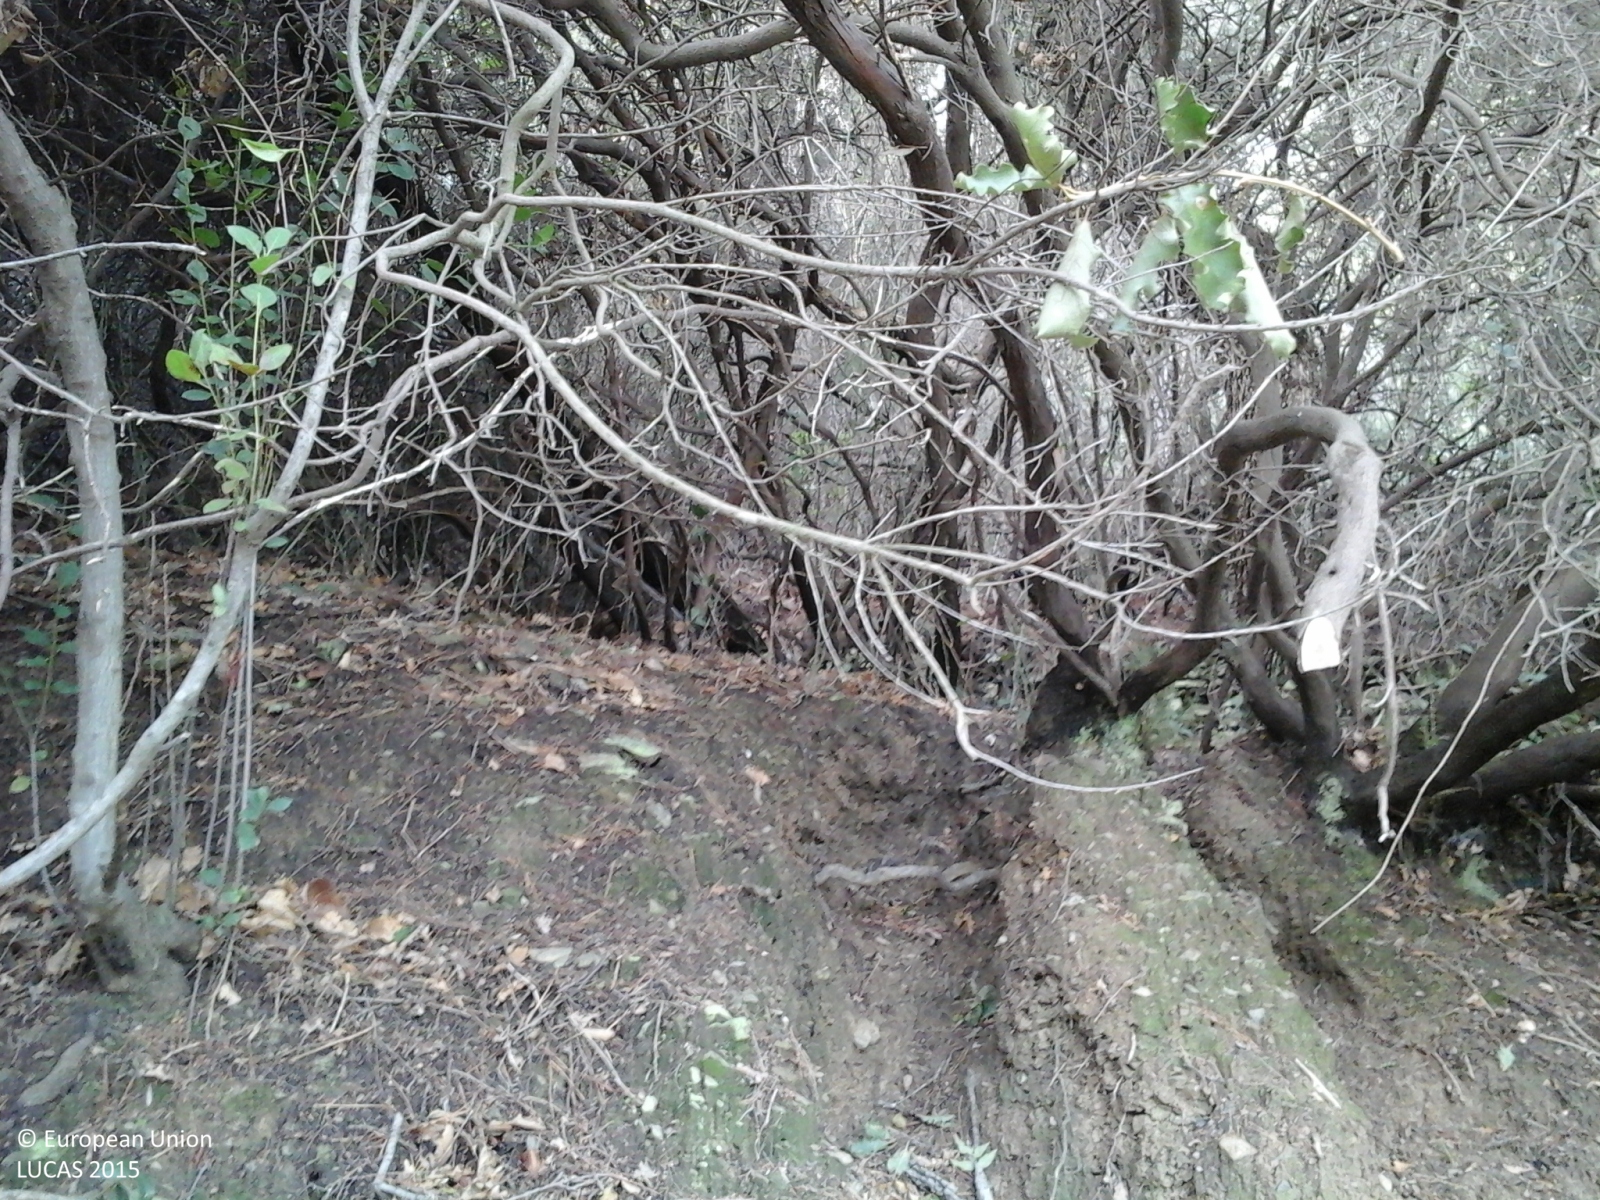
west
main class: Woodland
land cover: Other mixed woodland
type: broadleaved evergreen forest
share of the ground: > 75 %
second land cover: Shrubland without tree cover
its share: 10 - 25 %
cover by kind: broadleaved forest trees 50 %, coniferous forest trees 20 %, shrubs 20 %, herbaceous plants 10 %
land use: Semi-natural and natural areas not in use
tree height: > 5 m
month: October
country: IT
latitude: 44.0092
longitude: 8.1460
